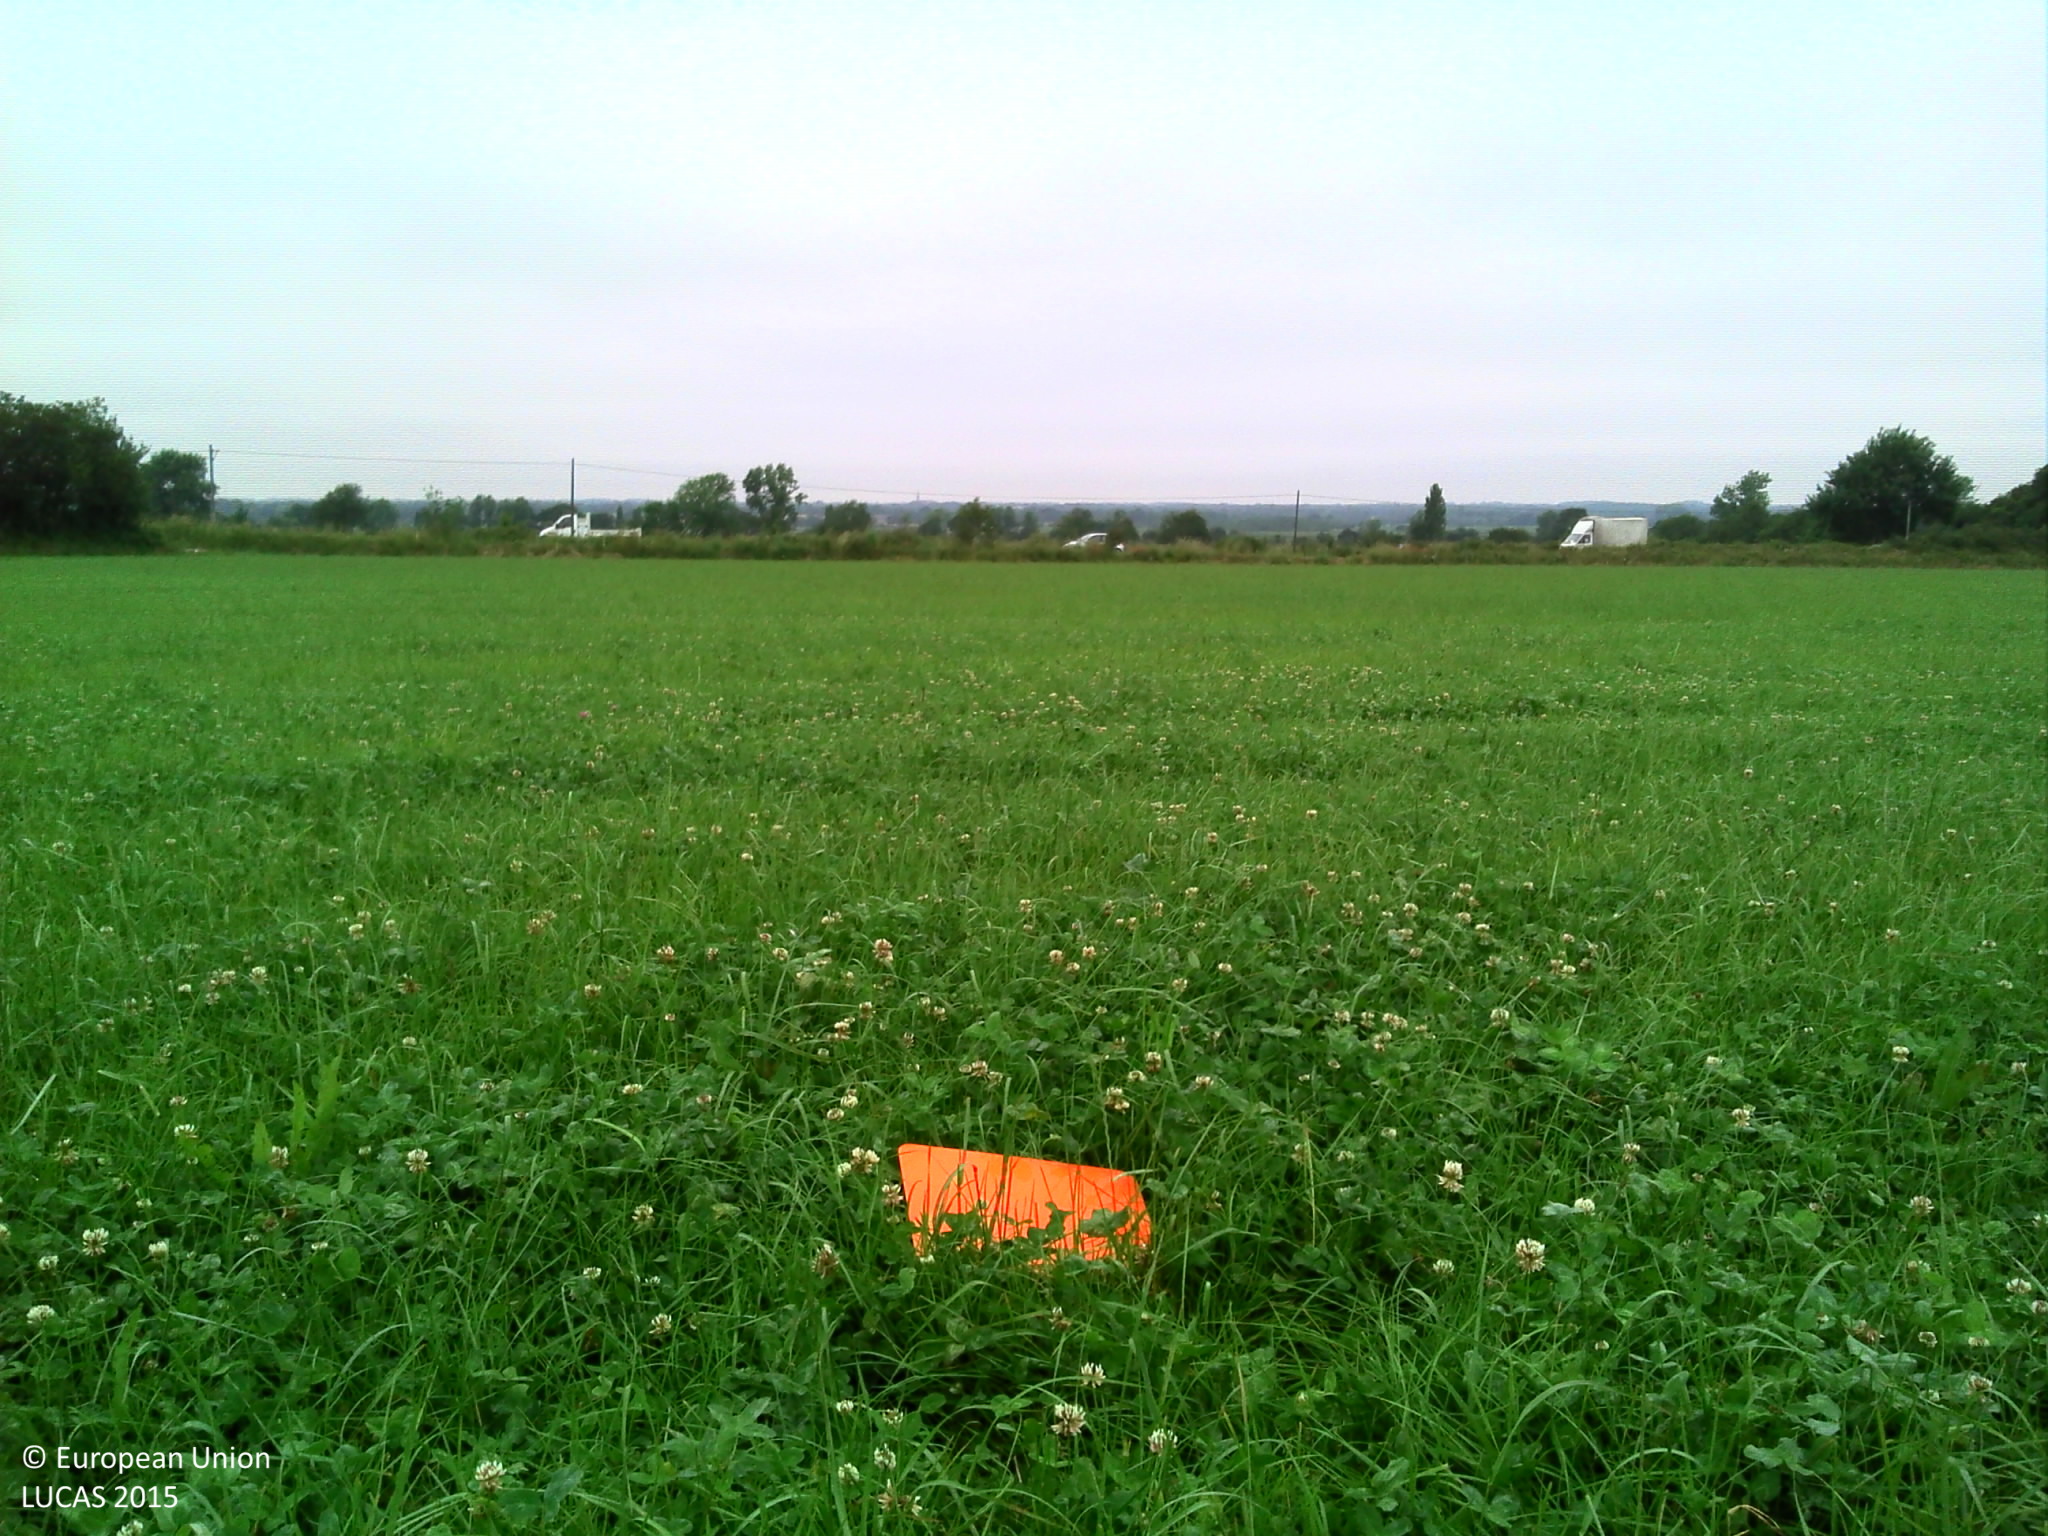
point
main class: Cropland
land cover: Temporary grasslands
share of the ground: > 75 %
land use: Agriculture (excluding fallow land and kitchen gardens)
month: June
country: FR
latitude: 47.1105
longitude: -2.0003
